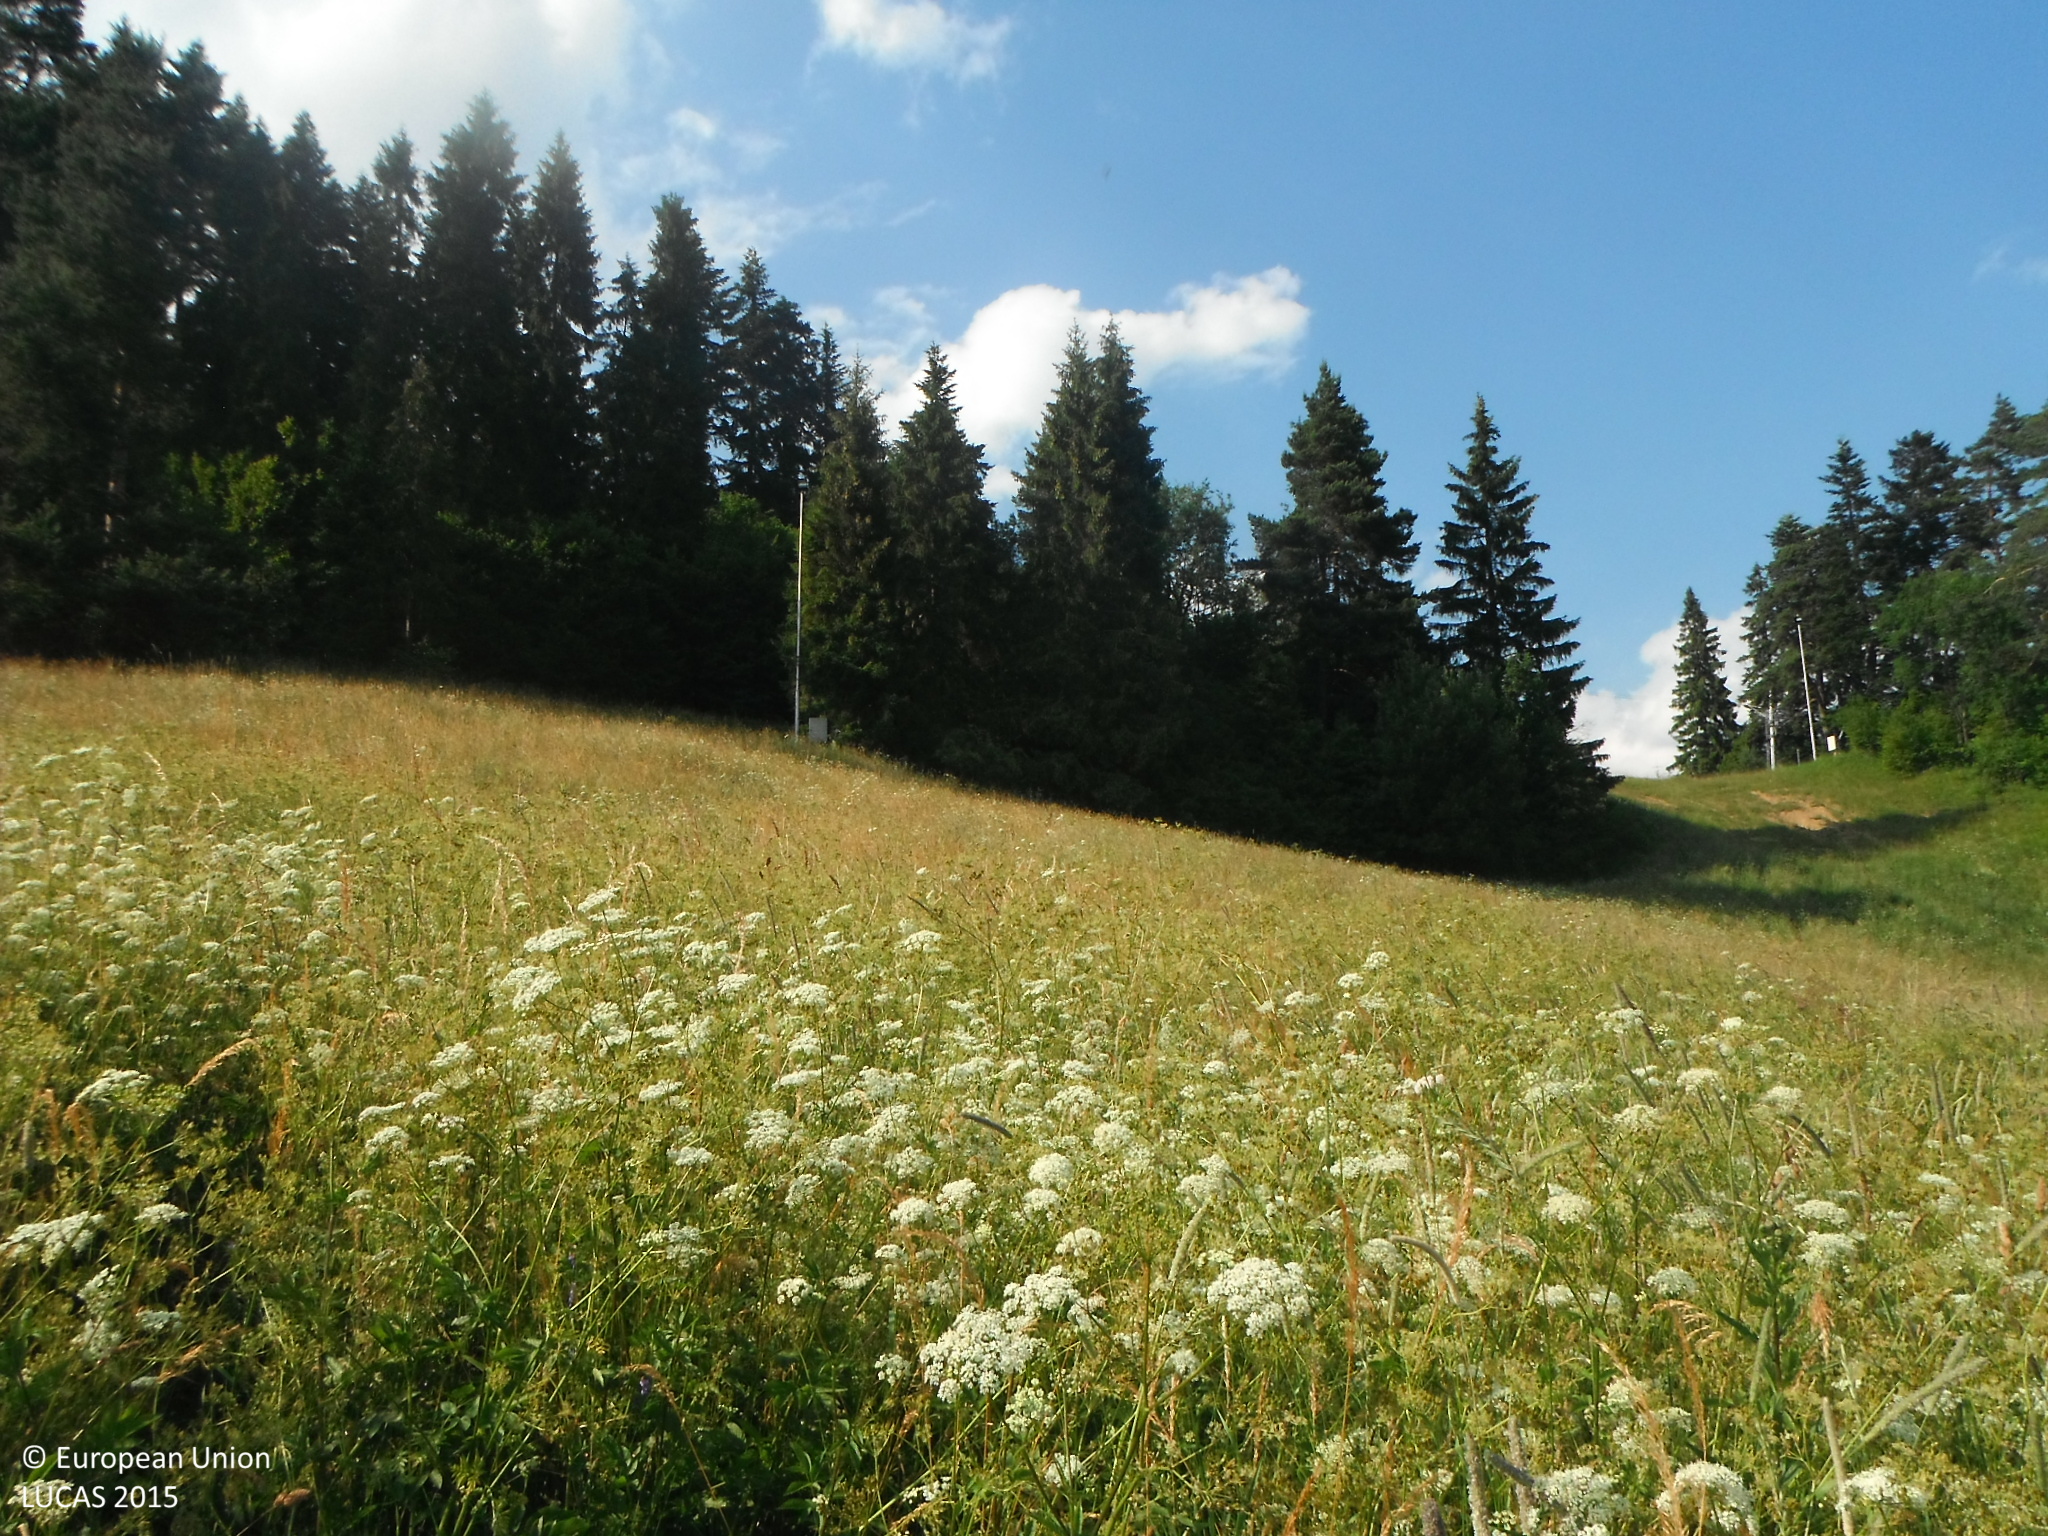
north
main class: Grassland
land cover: Grassland without tree/shrub cover
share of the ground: > 75 %
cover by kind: herbaceous plants 100 %
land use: Agriculture (excluding fallow land and kitchen gardens)
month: July
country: SK
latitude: 49.3115
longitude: 20.5599
